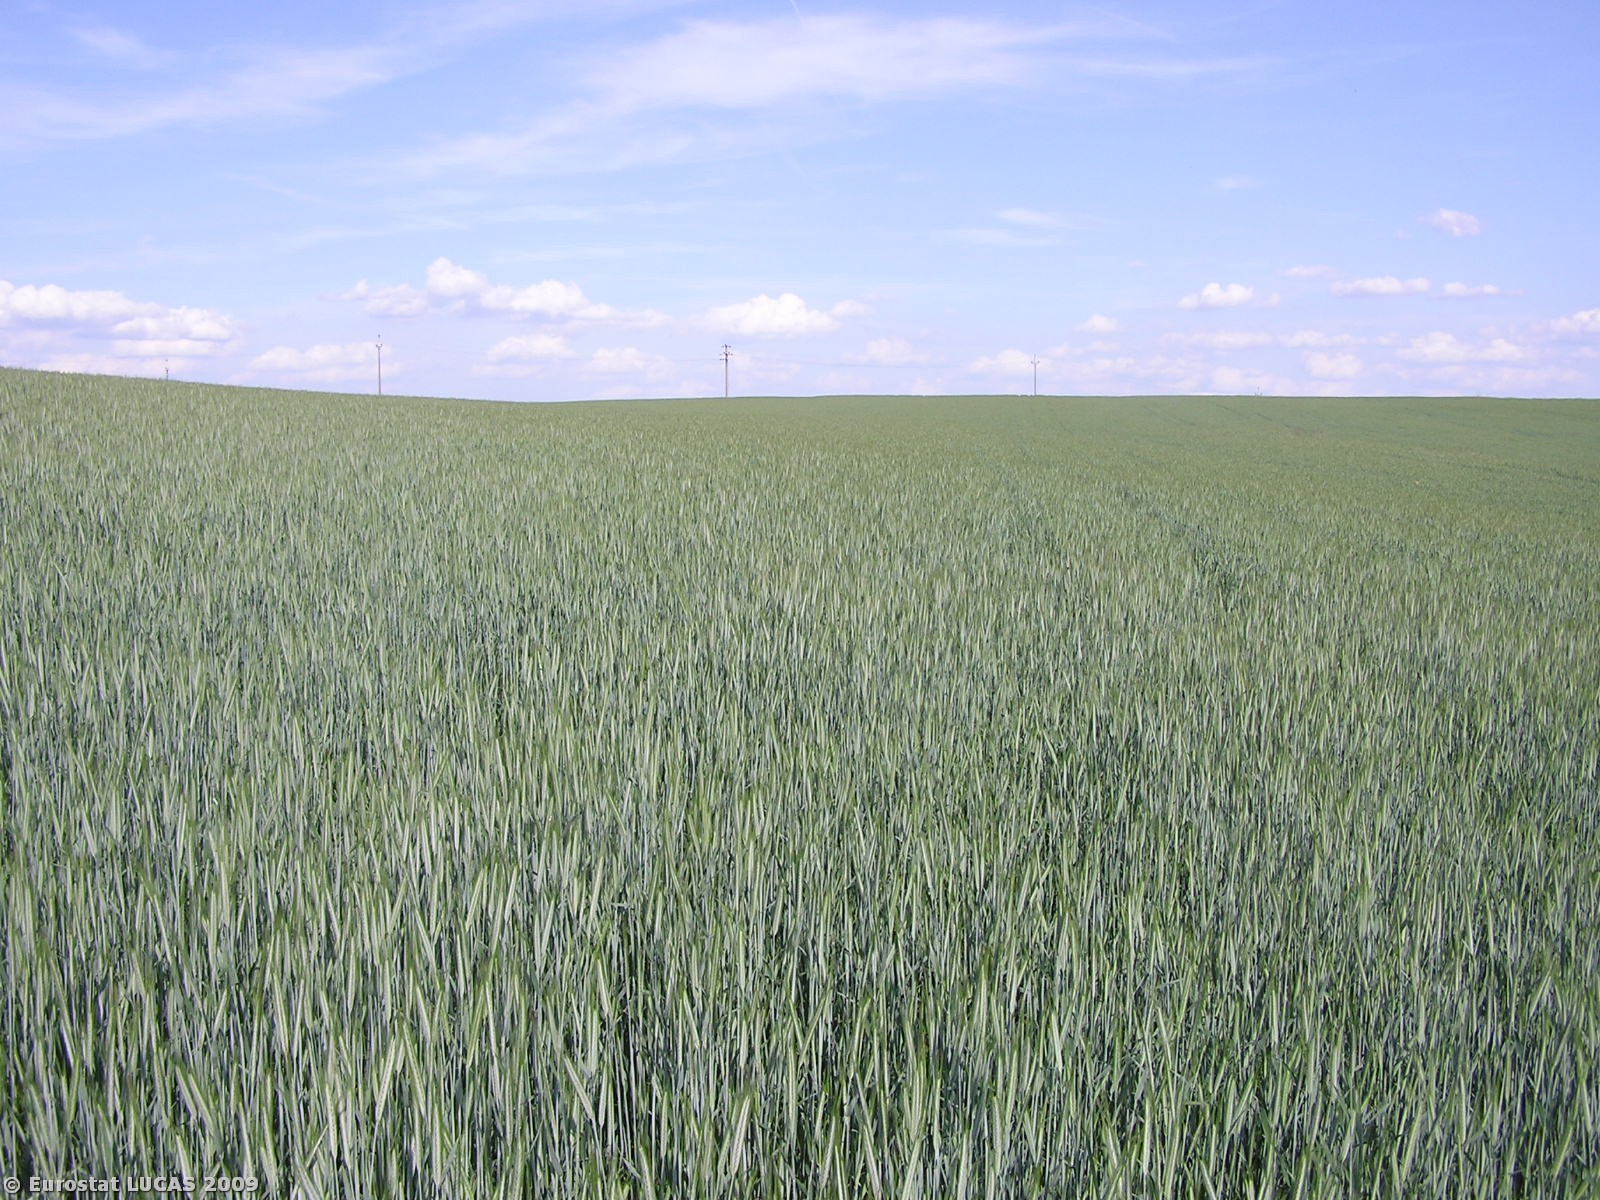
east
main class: Cropland
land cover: Rye
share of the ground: > 75 %
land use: Agriculture (excluding fallow land and kitchen gardens)
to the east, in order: Rye
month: May
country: CZ
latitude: 49.5509
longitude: 14.6045
